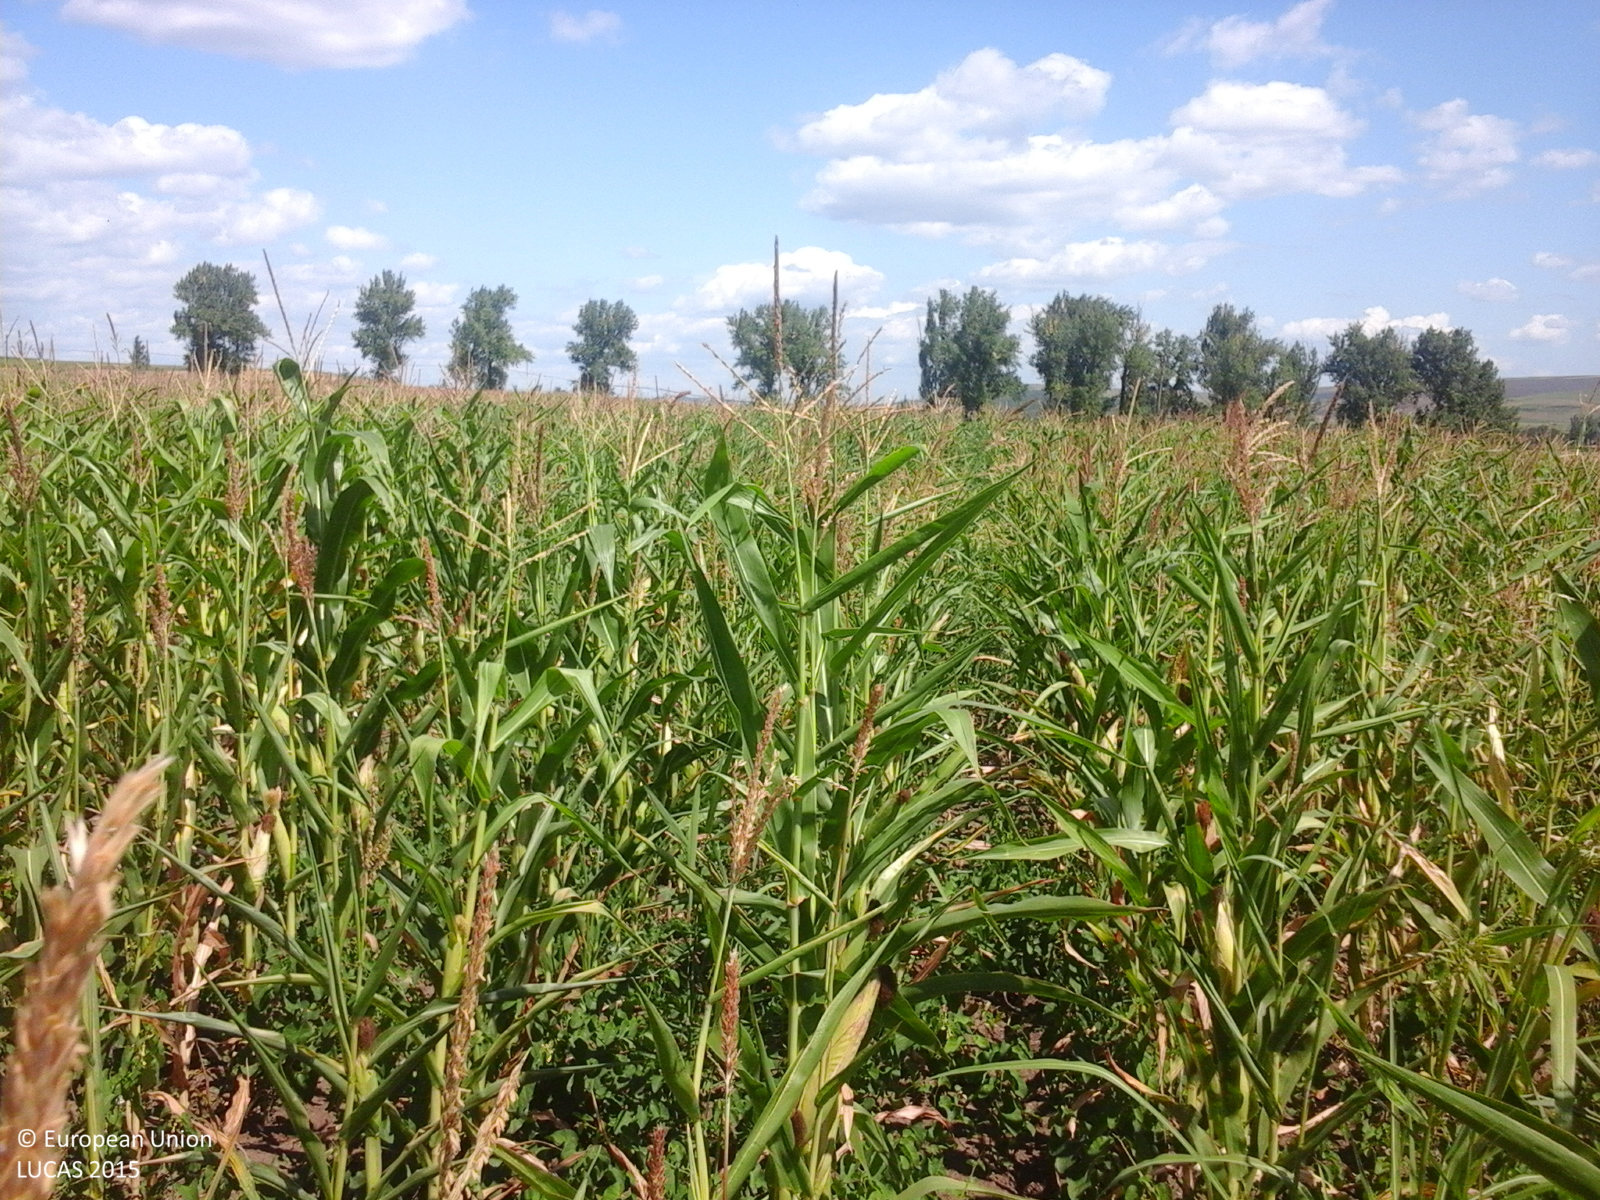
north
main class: Cropland
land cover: Maize
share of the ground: > 75 %
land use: Agriculture (excluding fallow land and kitchen gardens)
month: July
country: RO
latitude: 46.0771
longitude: 27.4720
